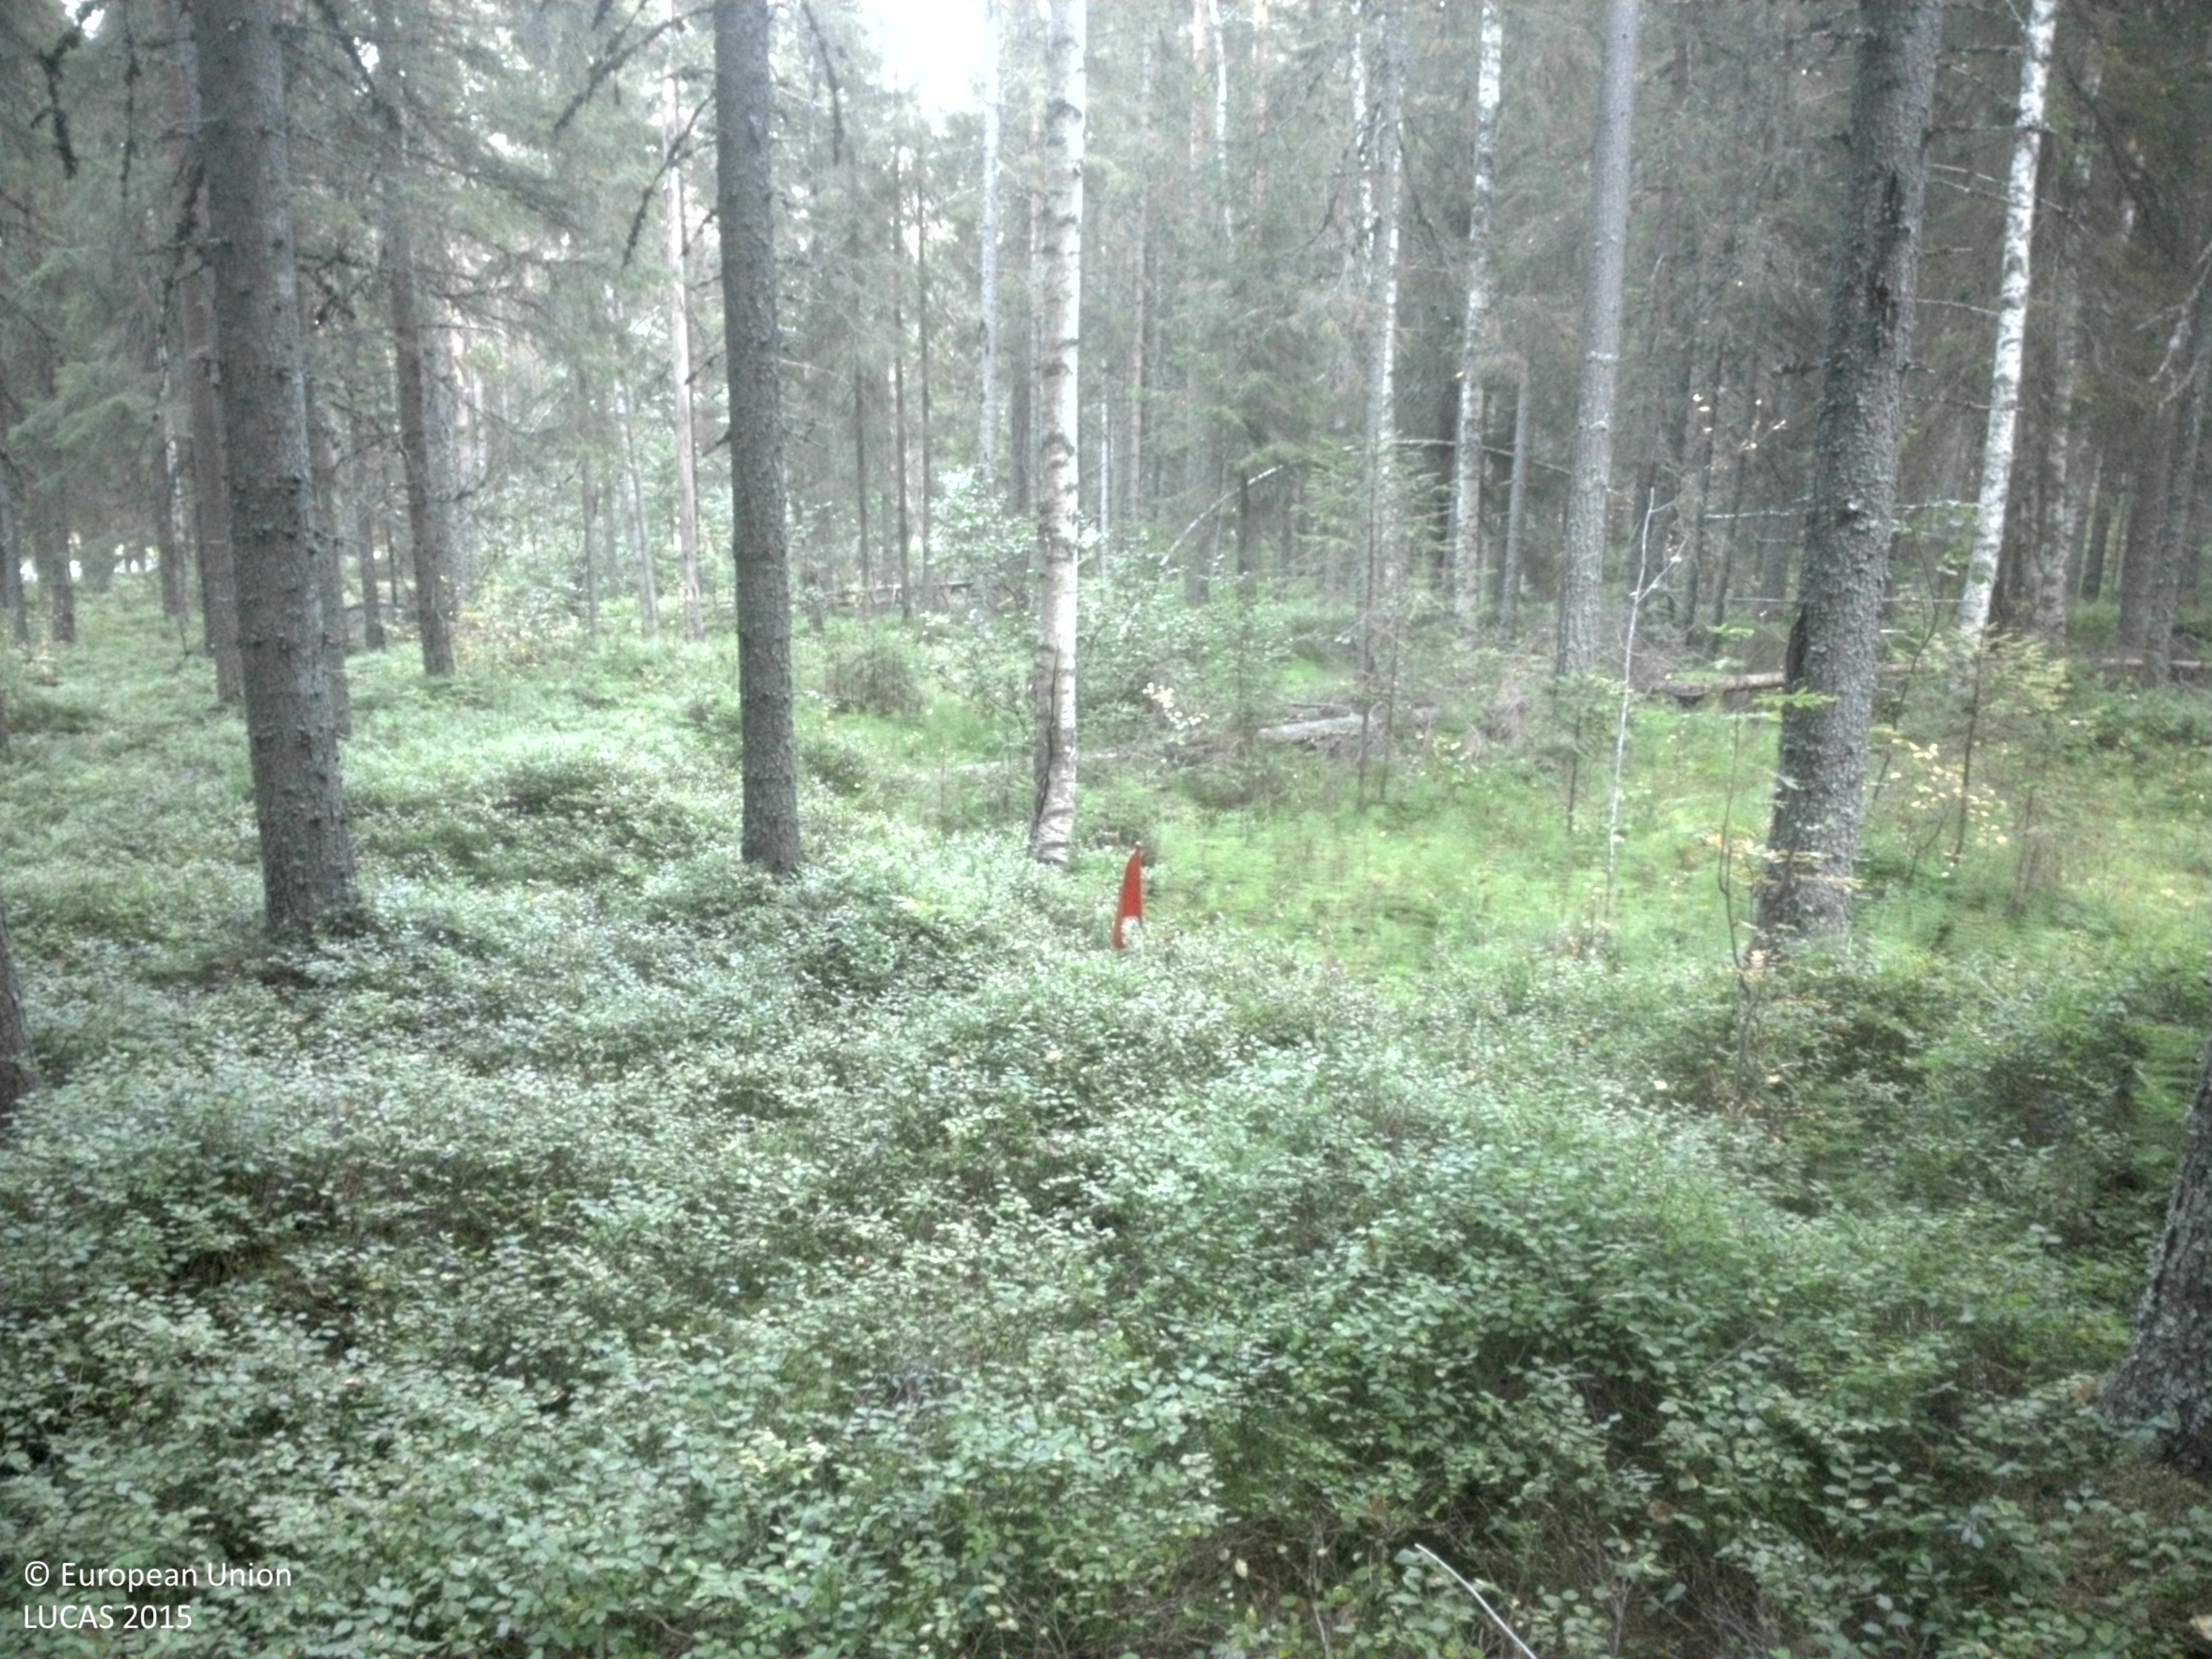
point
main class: Woodland
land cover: Spruce dominated coniferous woodland
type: boreal forest
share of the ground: 50 - 75 %
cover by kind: coniferous forest trees 75 %, shrubs 25 %
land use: Forestry
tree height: > 5 m
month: September
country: SE
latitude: 64.3402
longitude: 20.5140
